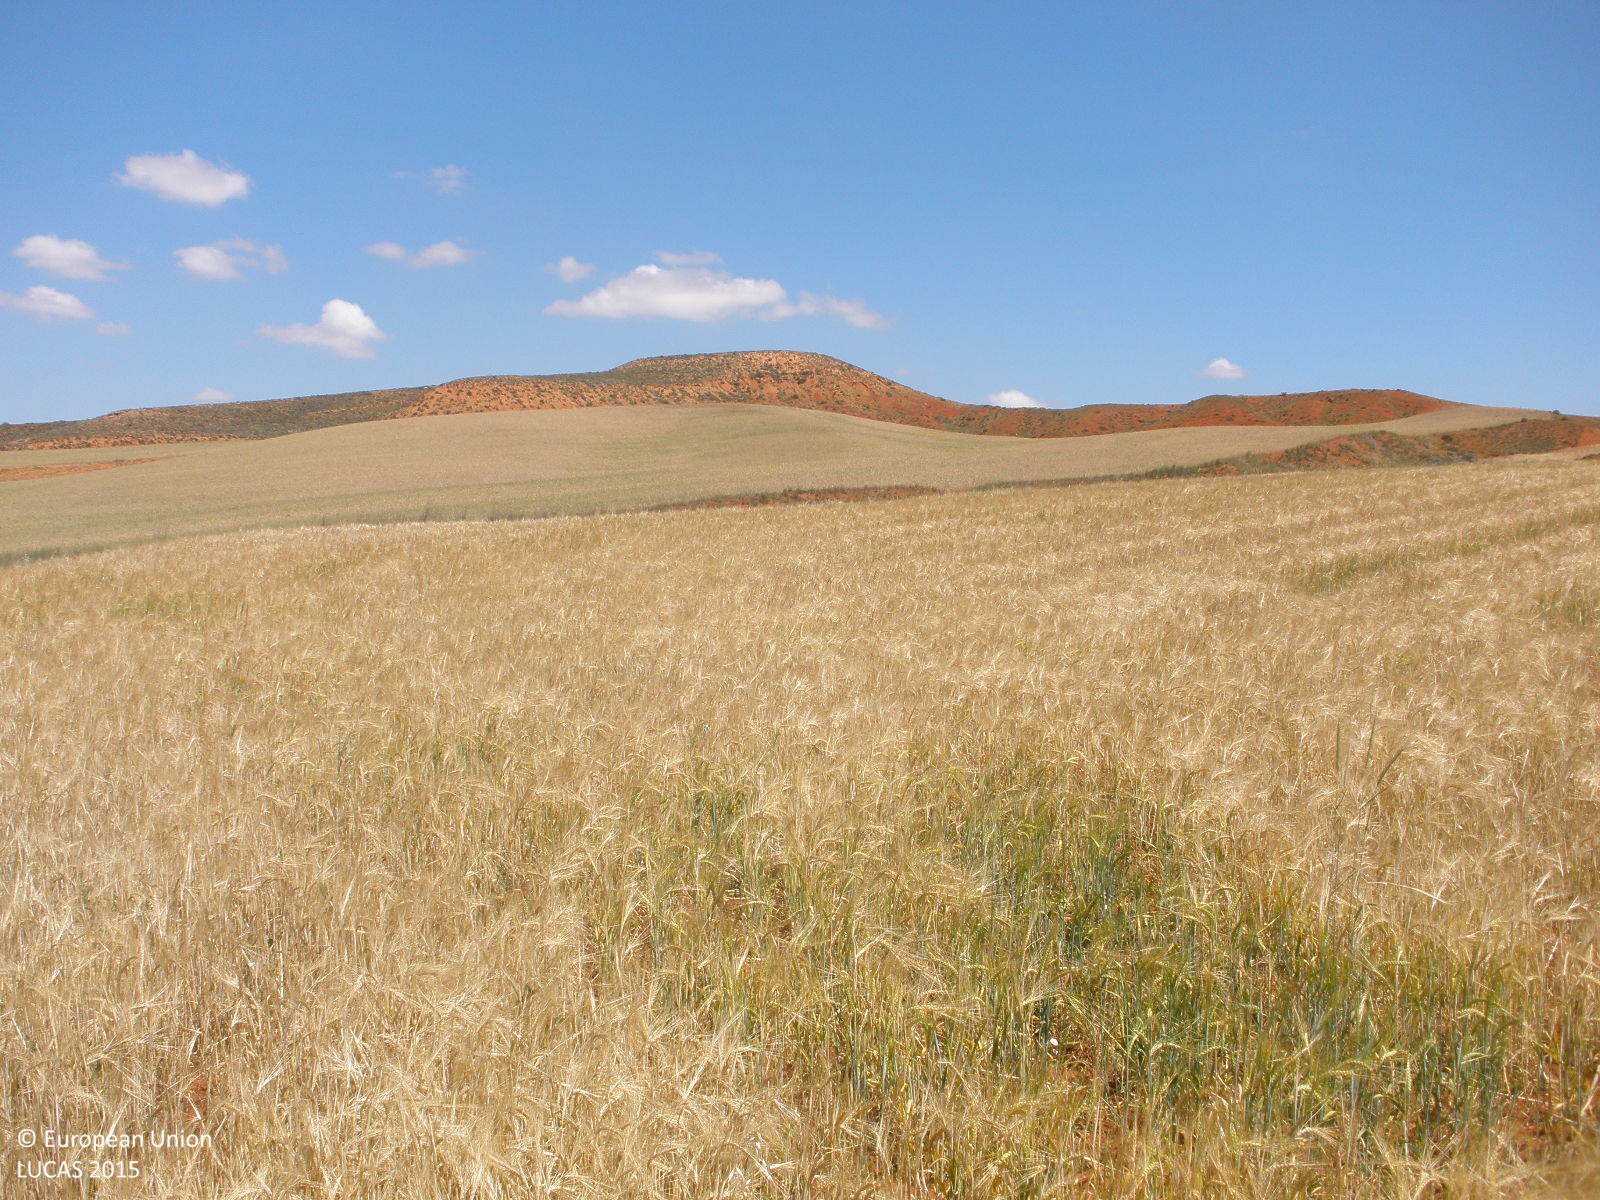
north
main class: Cropland
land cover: Barley
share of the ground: > 75 %
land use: Agriculture (excluding fallow land and kitchen gardens)
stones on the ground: < 10 %
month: June
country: ES
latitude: 40.5528
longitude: -1.0539
